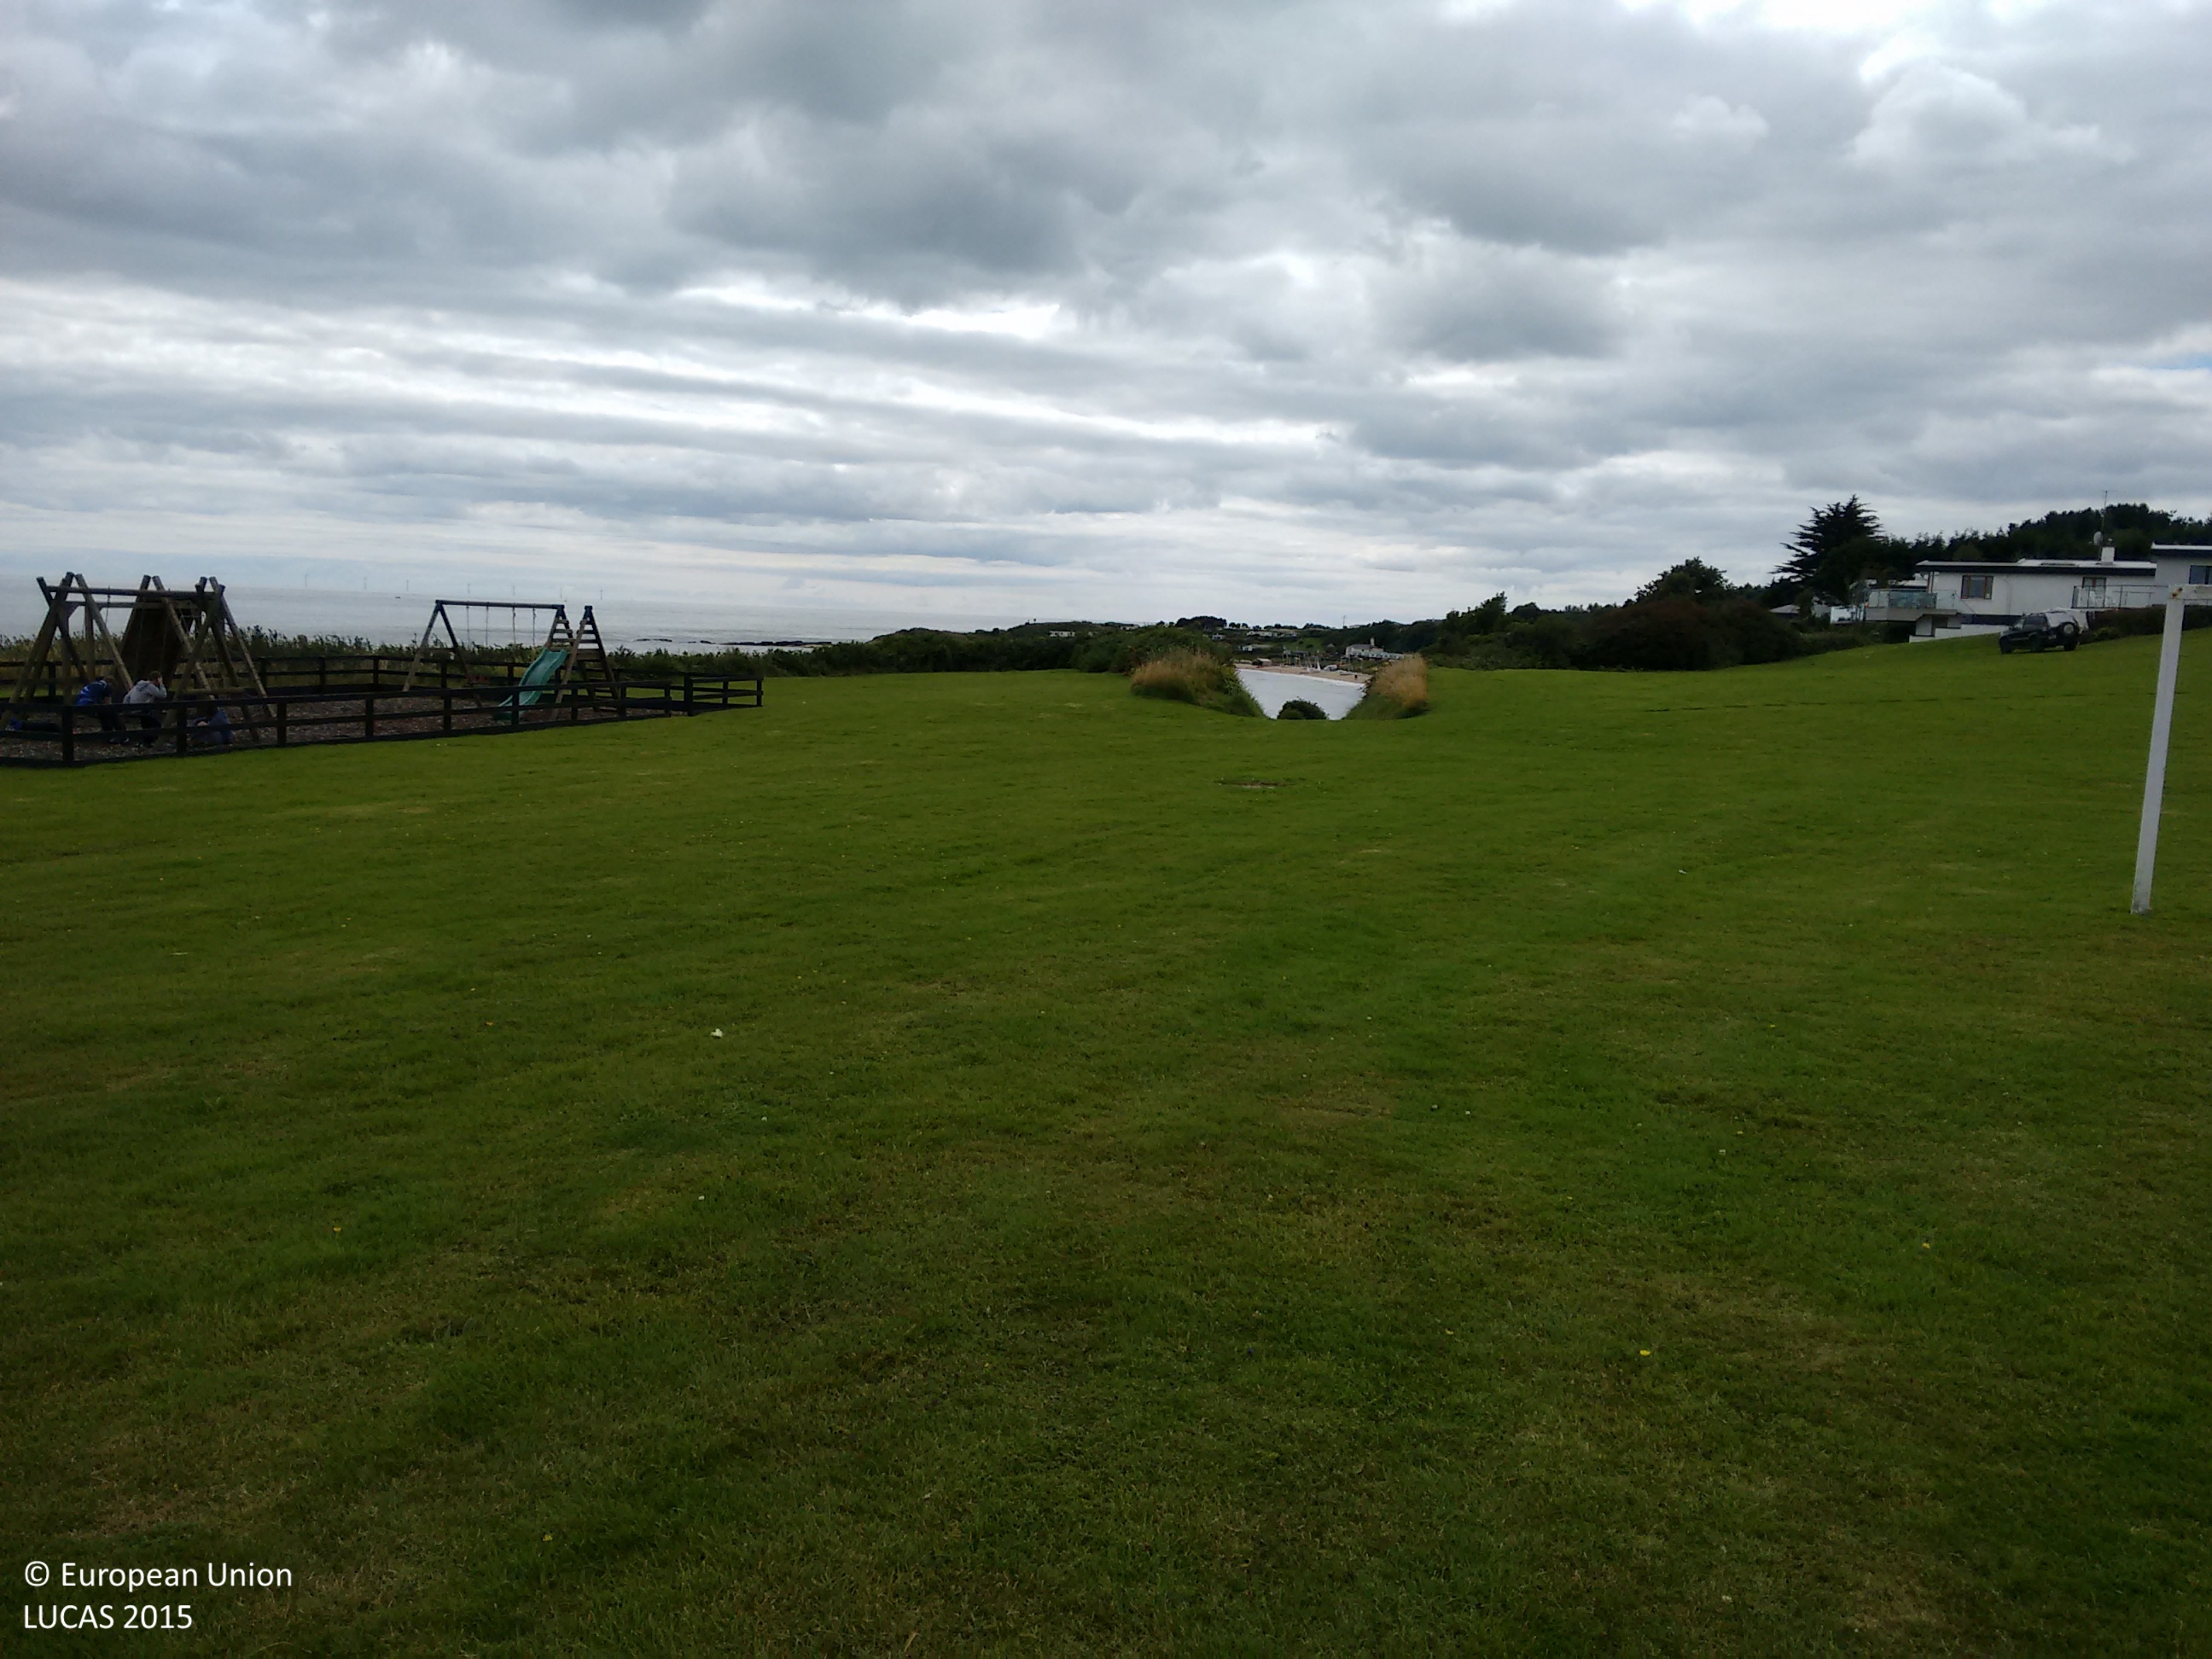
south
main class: Grassland
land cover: Grassland without tree/shrub cover
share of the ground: > 75 %
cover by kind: herbaceous plants 100 %
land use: Amenities, museums, leisure
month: July
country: IE
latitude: 52.9099
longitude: -6.0396
